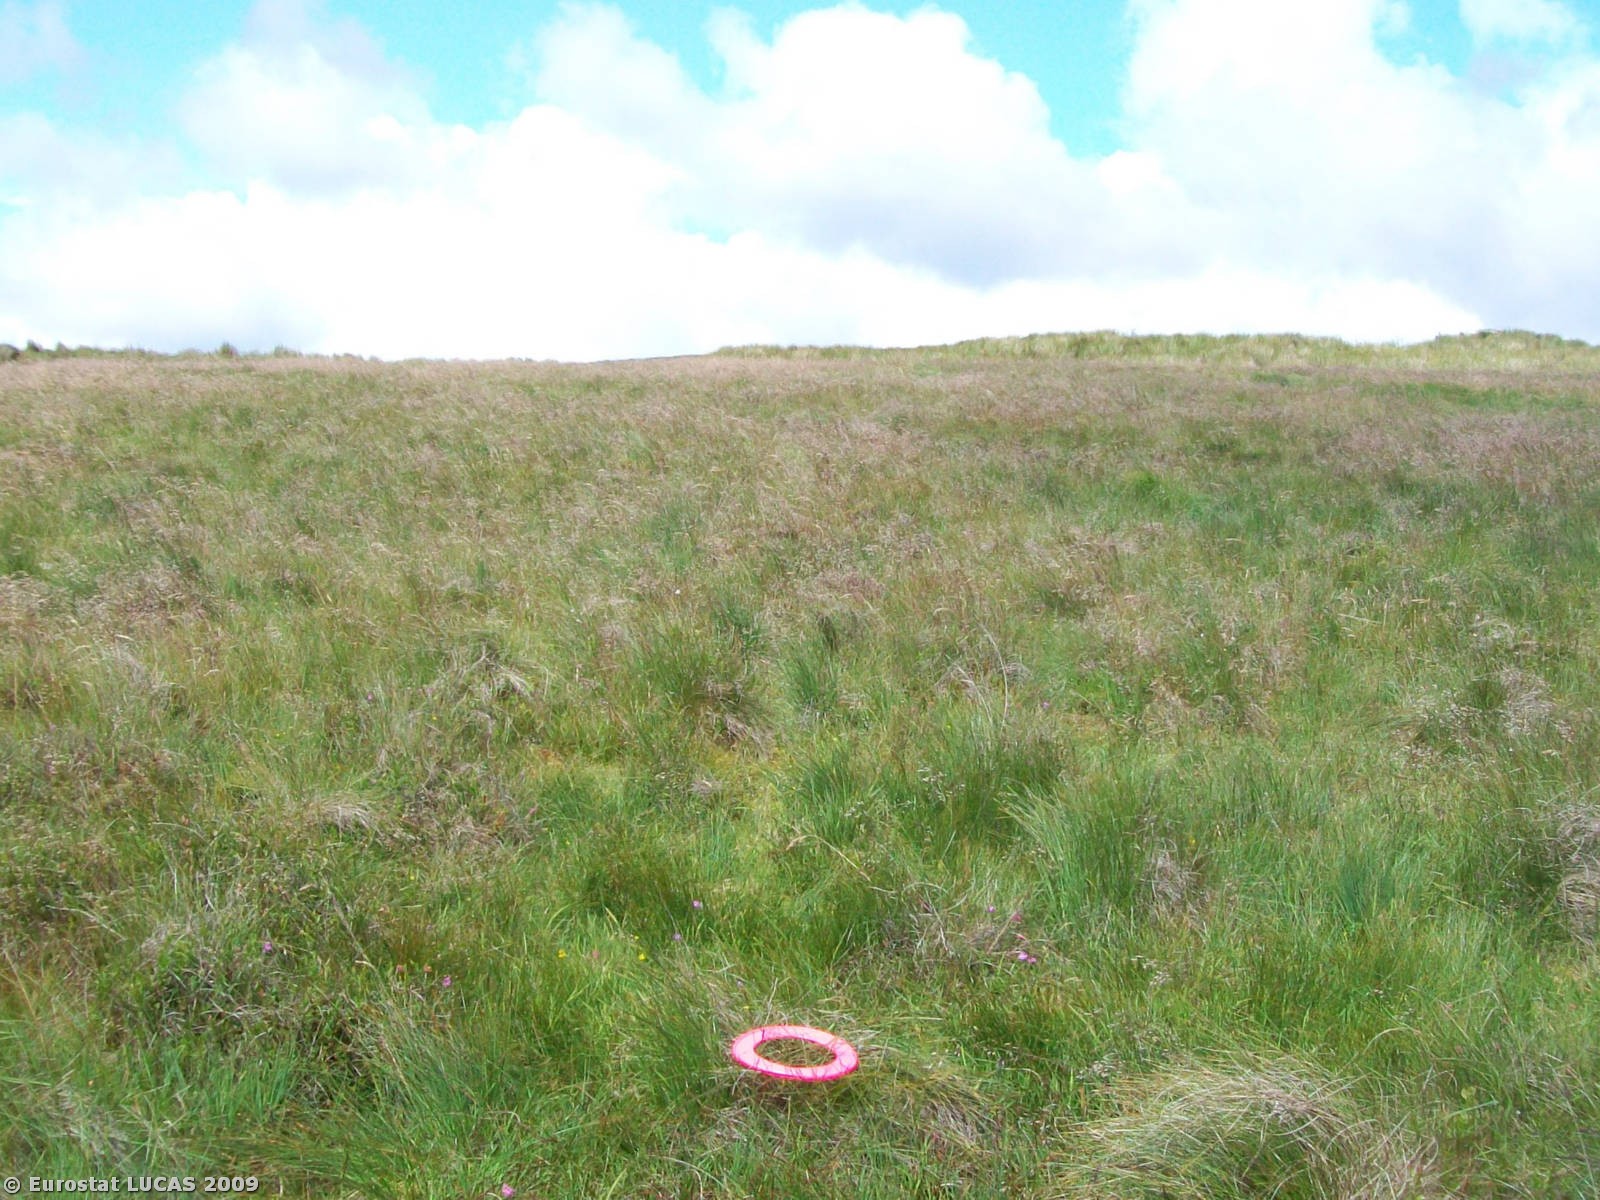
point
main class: Wetlands
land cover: Peatbogs
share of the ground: > 75 %
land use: Nature reserves
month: July
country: GB
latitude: 54.9913
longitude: -6.1324
